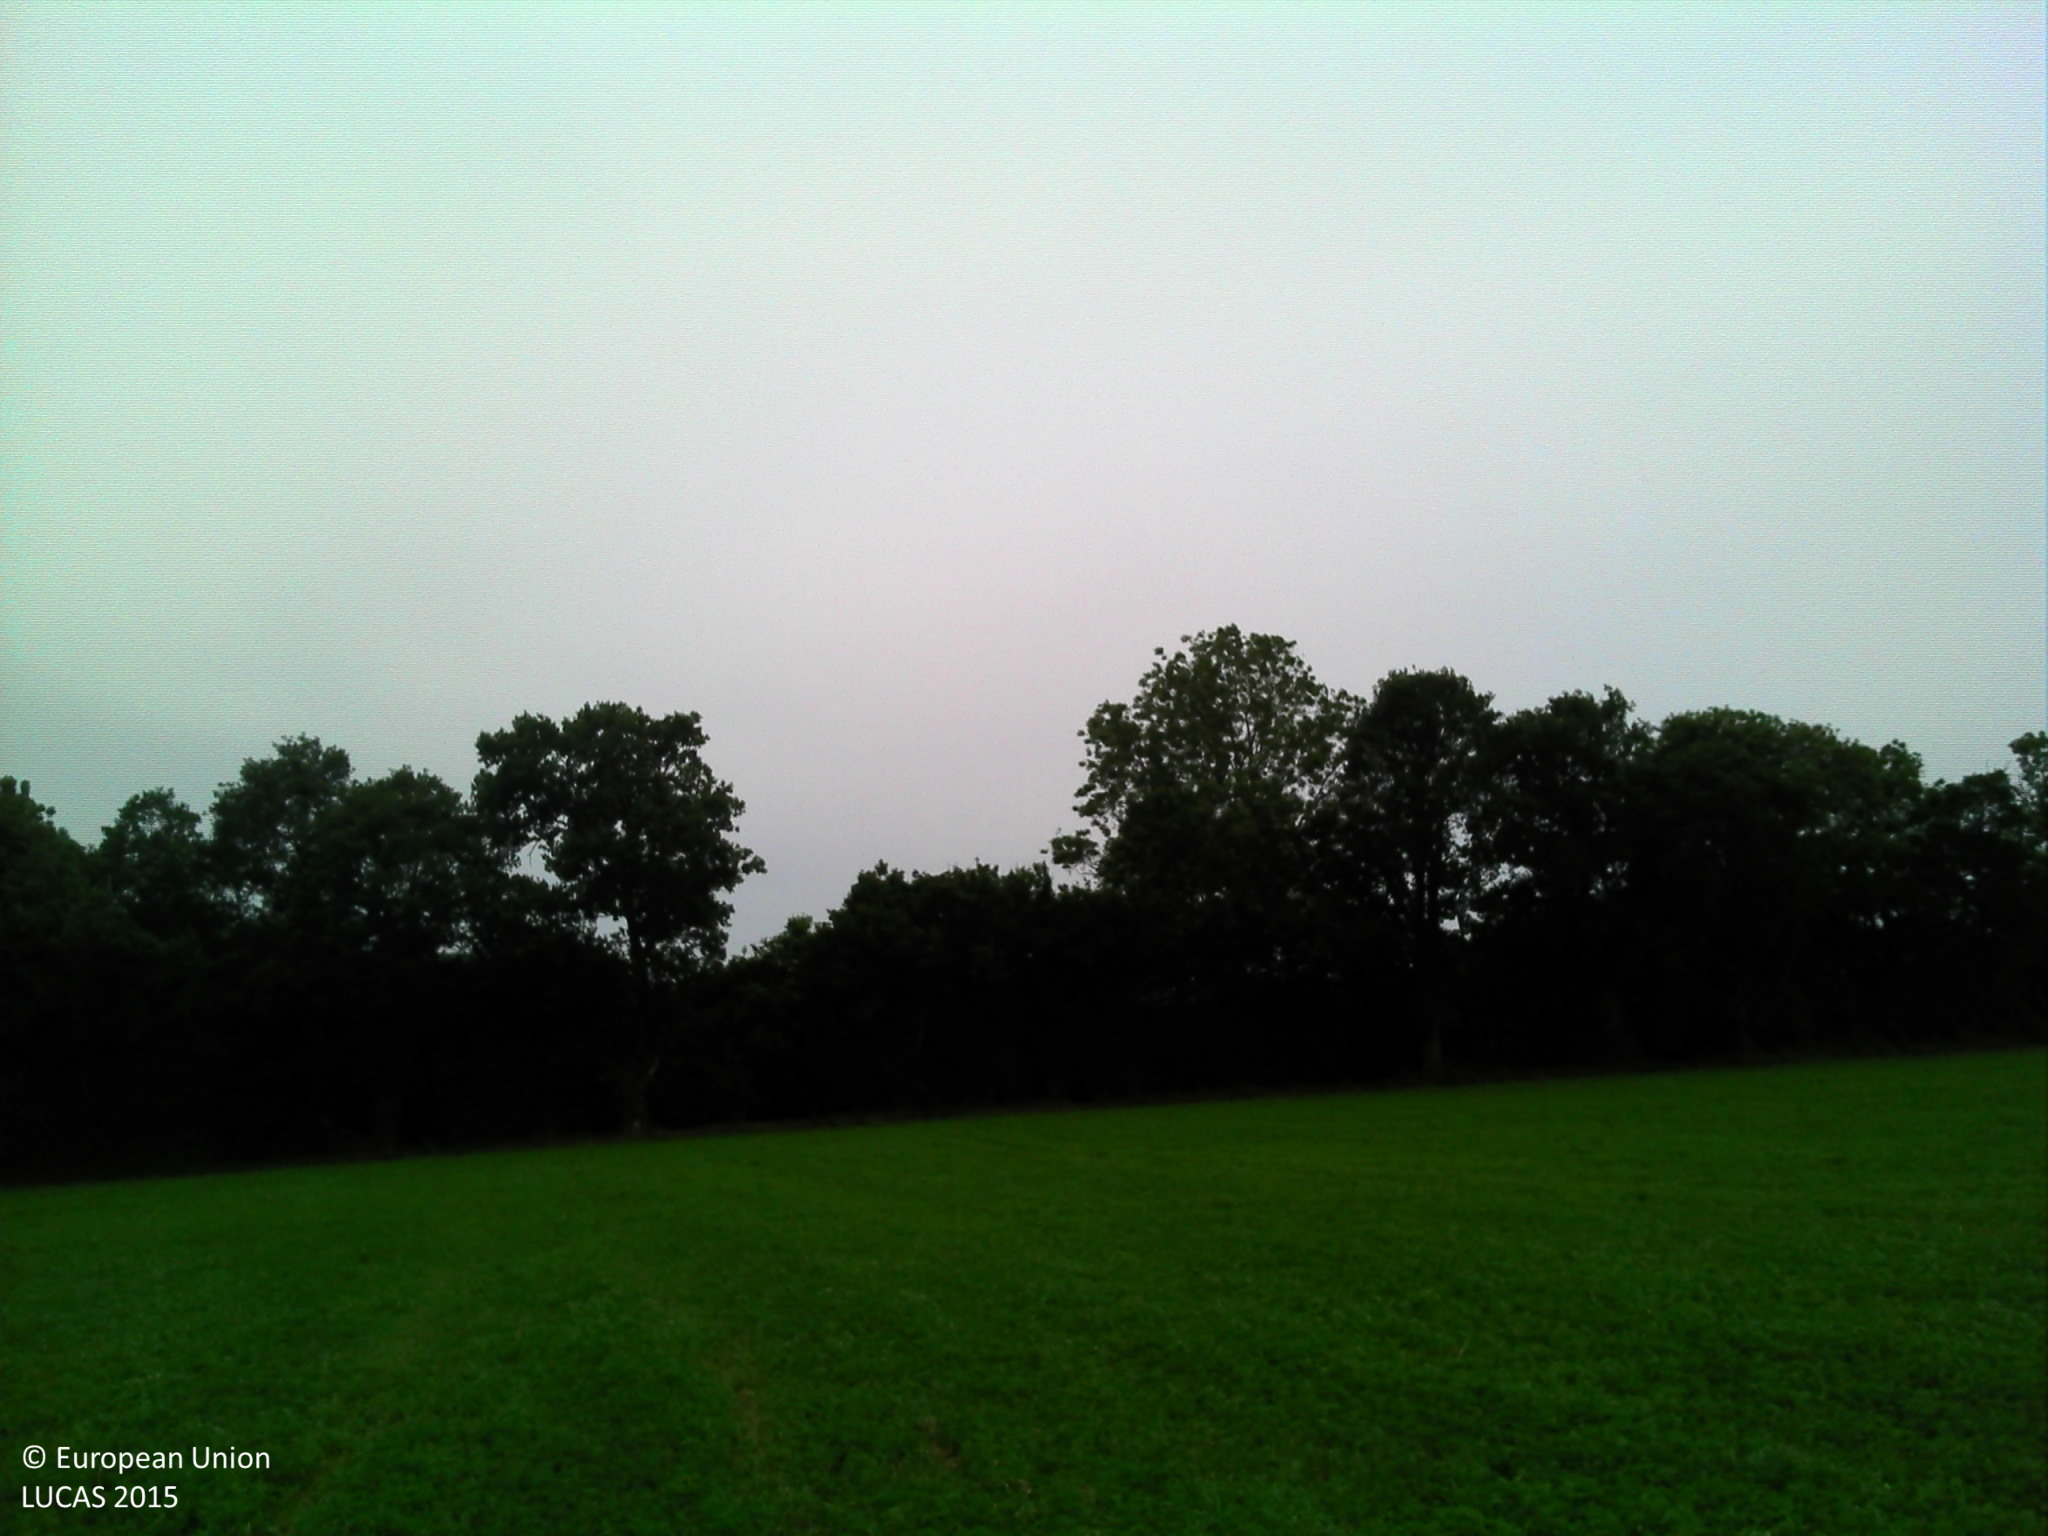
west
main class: Cropland
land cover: Other leguminous and mixtures for fodder
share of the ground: > 75 %
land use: Agriculture (excluding fallow land and kitchen gardens)
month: June
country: FR
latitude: 48.2361
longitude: -0.0329
